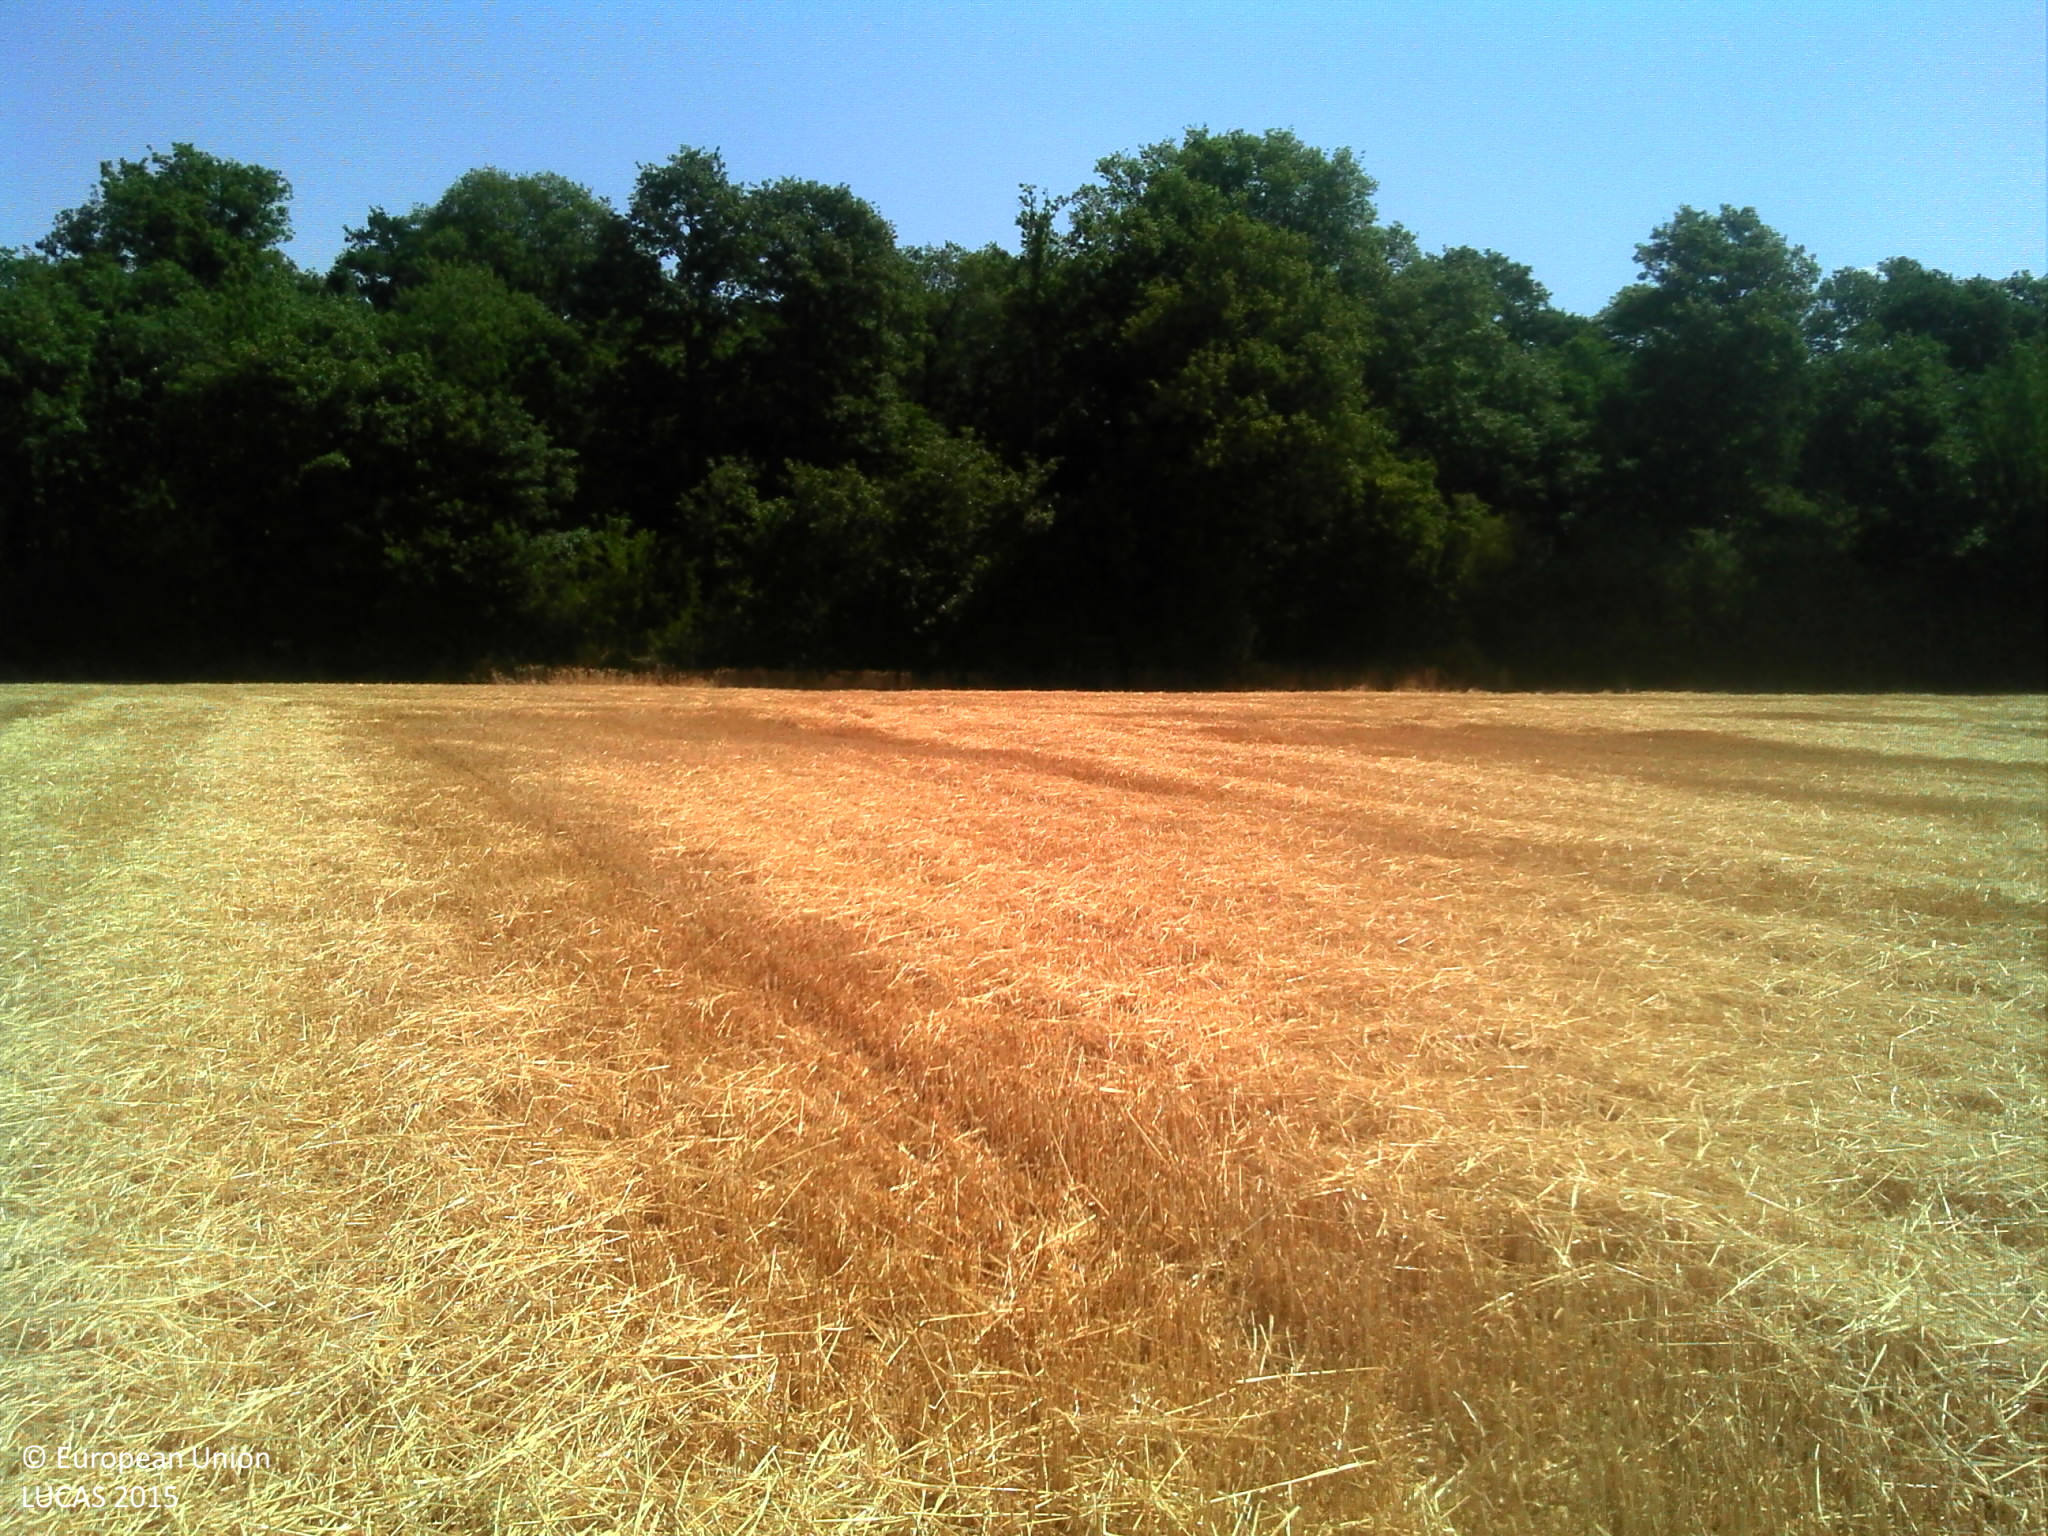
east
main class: Cropland
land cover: Common wheat
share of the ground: > 75 %
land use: Agriculture (excluding fallow land and kitchen gardens)
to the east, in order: Common wheat; Tracks; Broadleaved woodland; Common wheat
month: July
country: FR
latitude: 48.1337
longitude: 1.3158
